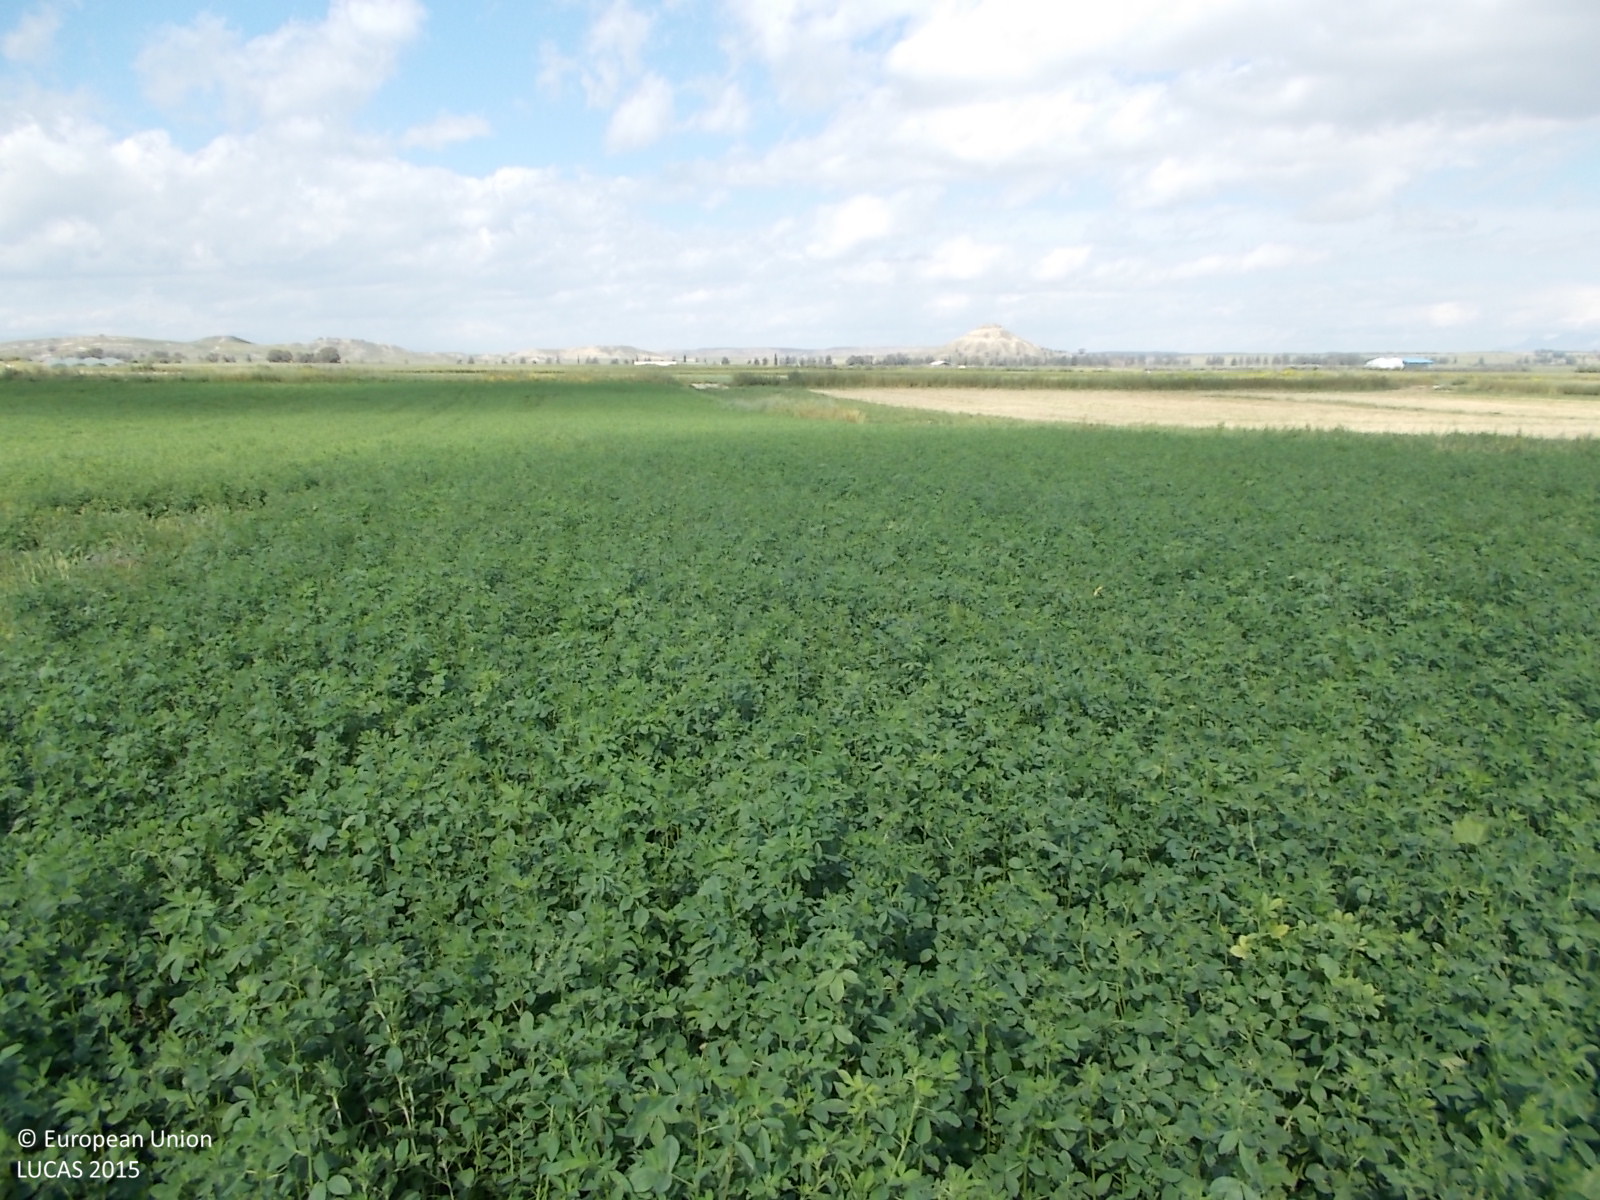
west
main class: Cropland
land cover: Lucerne
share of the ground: > 75 %
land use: Agriculture (excluding fallow land and kitchen gardens)
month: April
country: CY
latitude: 35.0544
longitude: 33.5170
